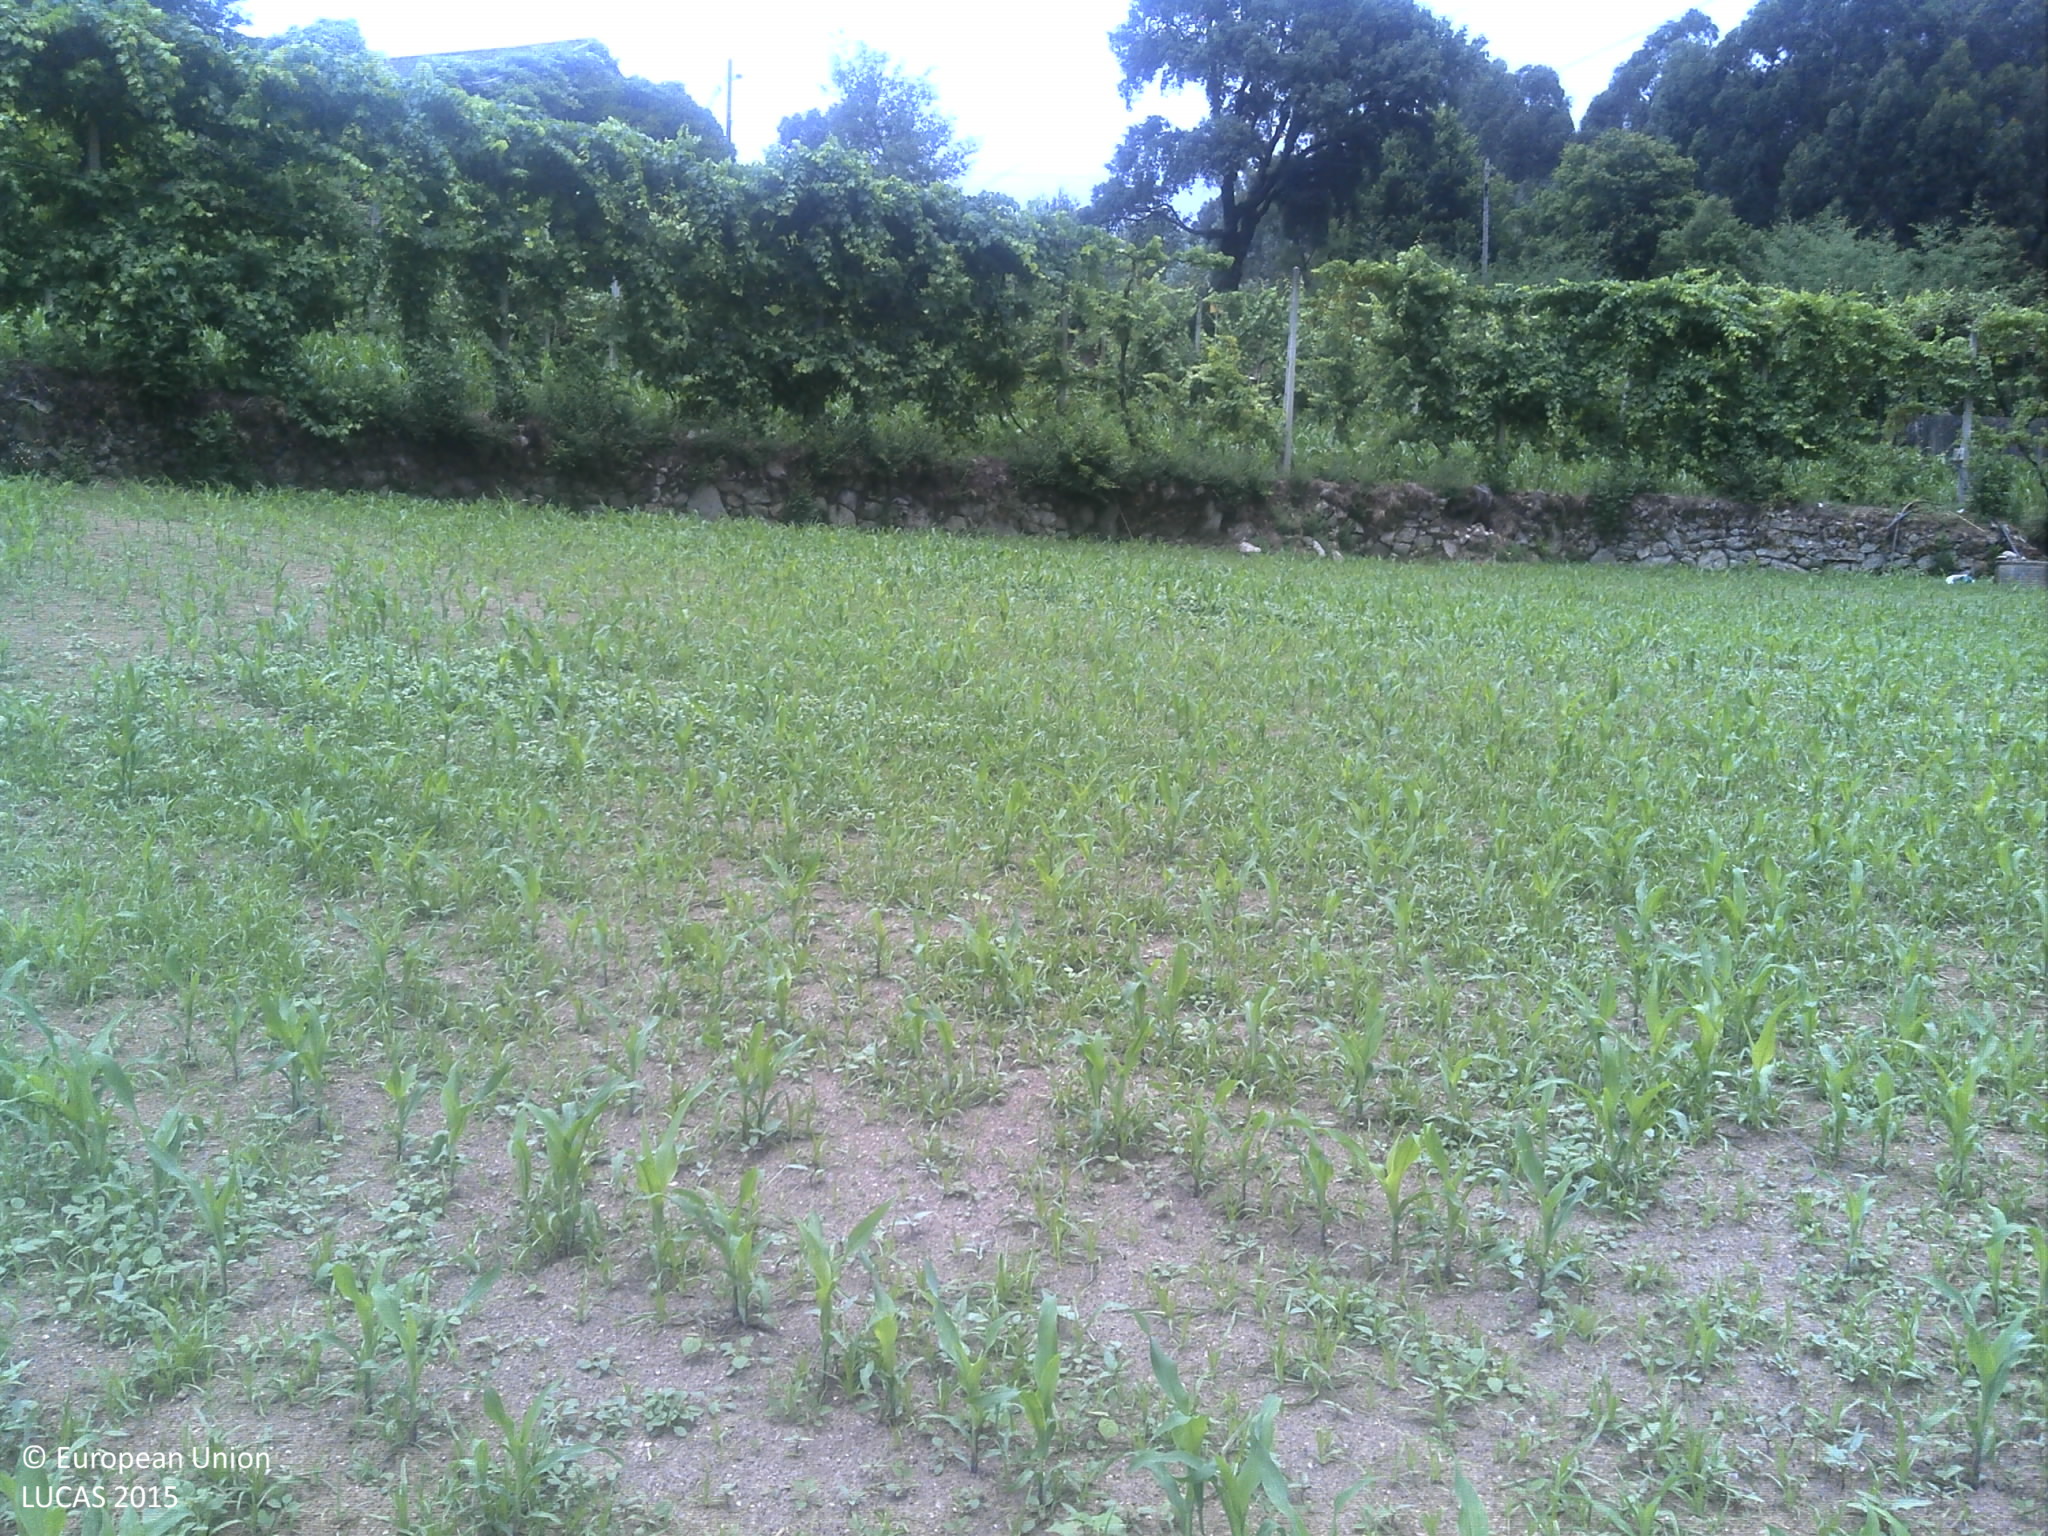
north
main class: Cropland
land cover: Maize
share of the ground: 10 - 25 %
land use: Agriculture (excluding fallow land and kitchen gardens)
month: June
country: PT
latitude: 41.6323
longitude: -8.3139
